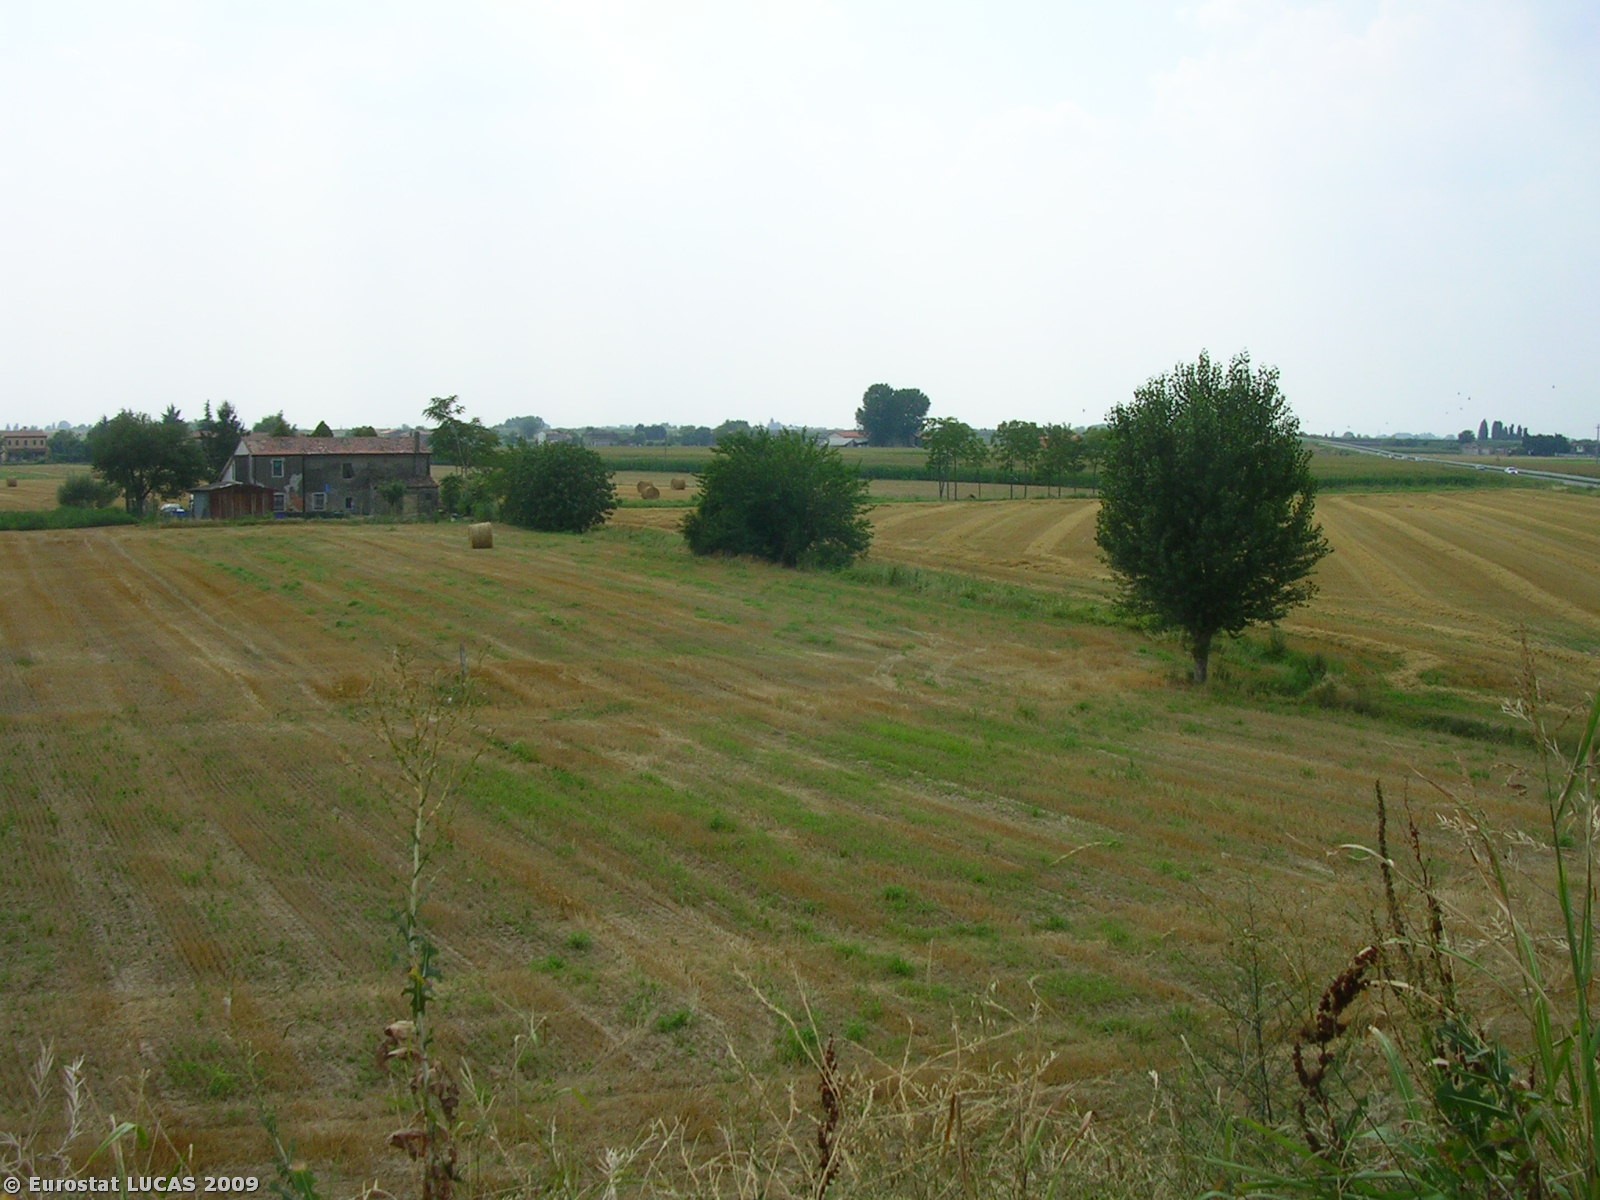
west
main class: Cropland
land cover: Common wheat
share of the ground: > 75 %
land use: Agriculture (excluding fallow land and kitchen gardens)
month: July
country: IT
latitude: 45.2028
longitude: 11.6648
